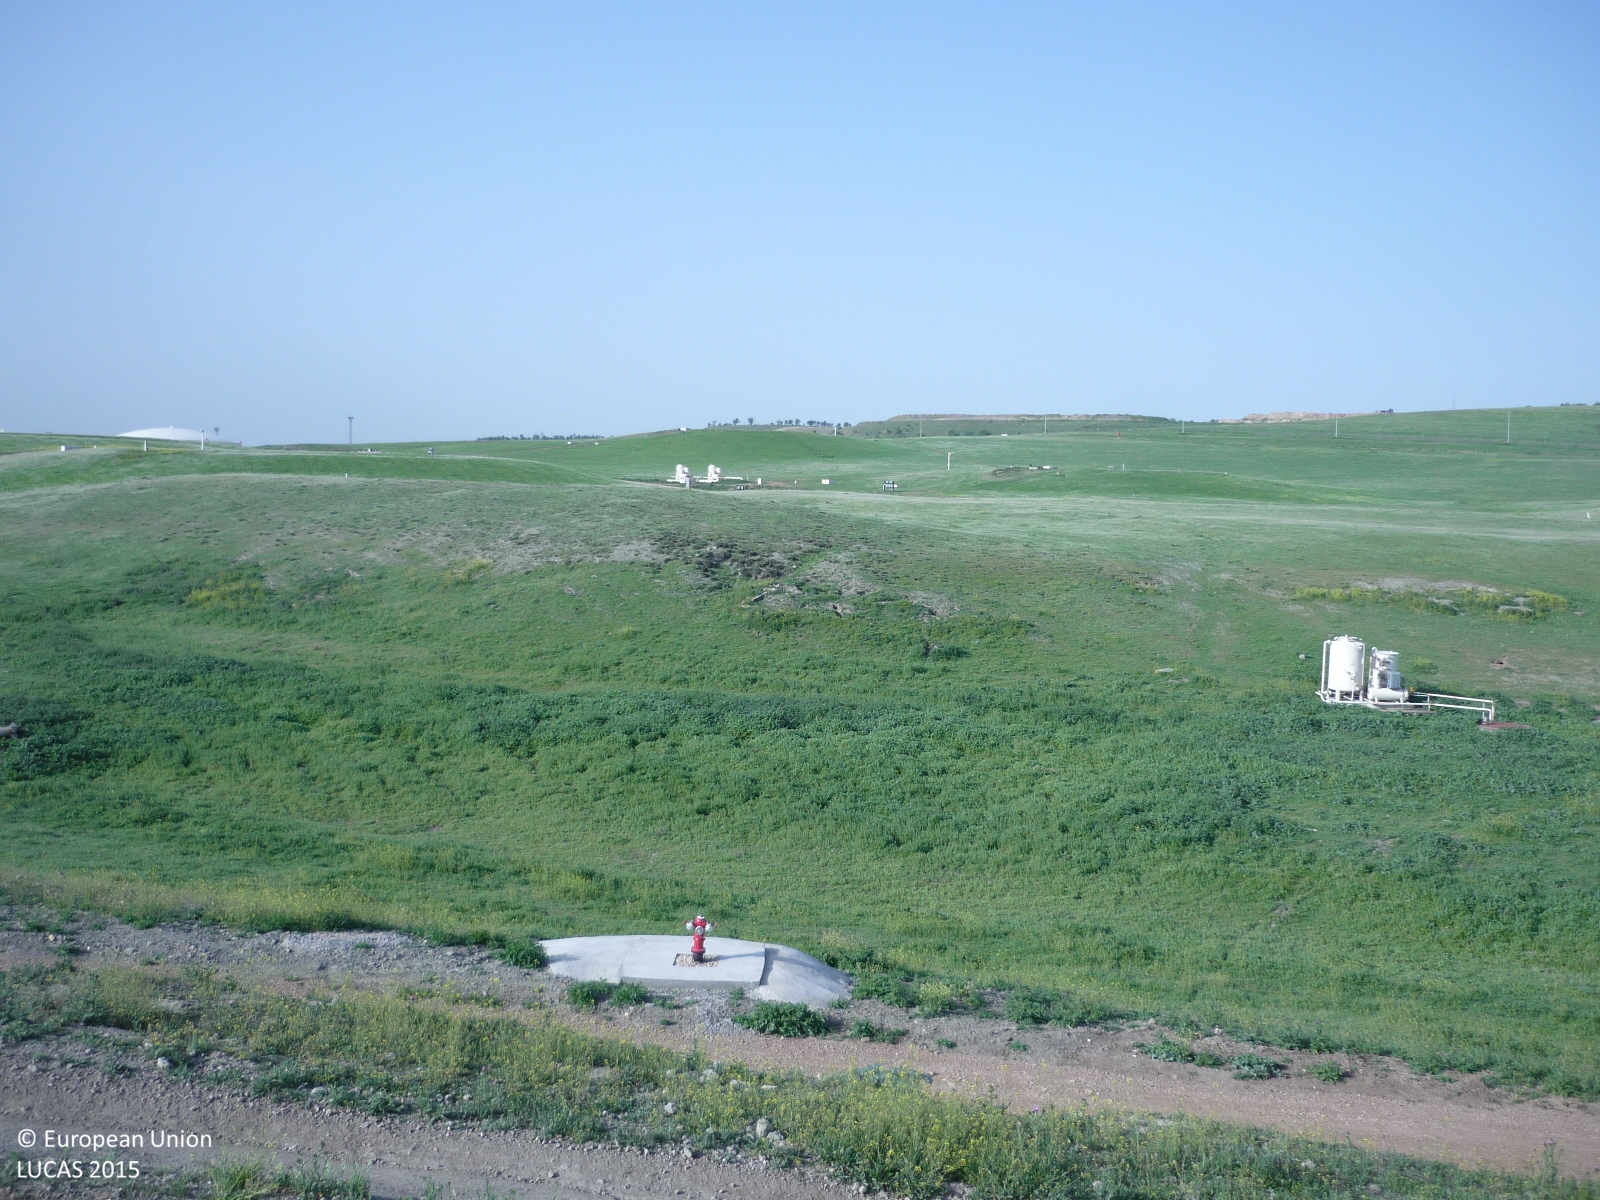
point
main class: Grassland
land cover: Grassland without tree/shrub cover
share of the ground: > 75 %
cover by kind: herbaceous plants 90 %, unconsolidated bare surface 10 %
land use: Electricity, gas and thermal power distribution
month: April
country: ES
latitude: 40.4190
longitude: -3.4343
